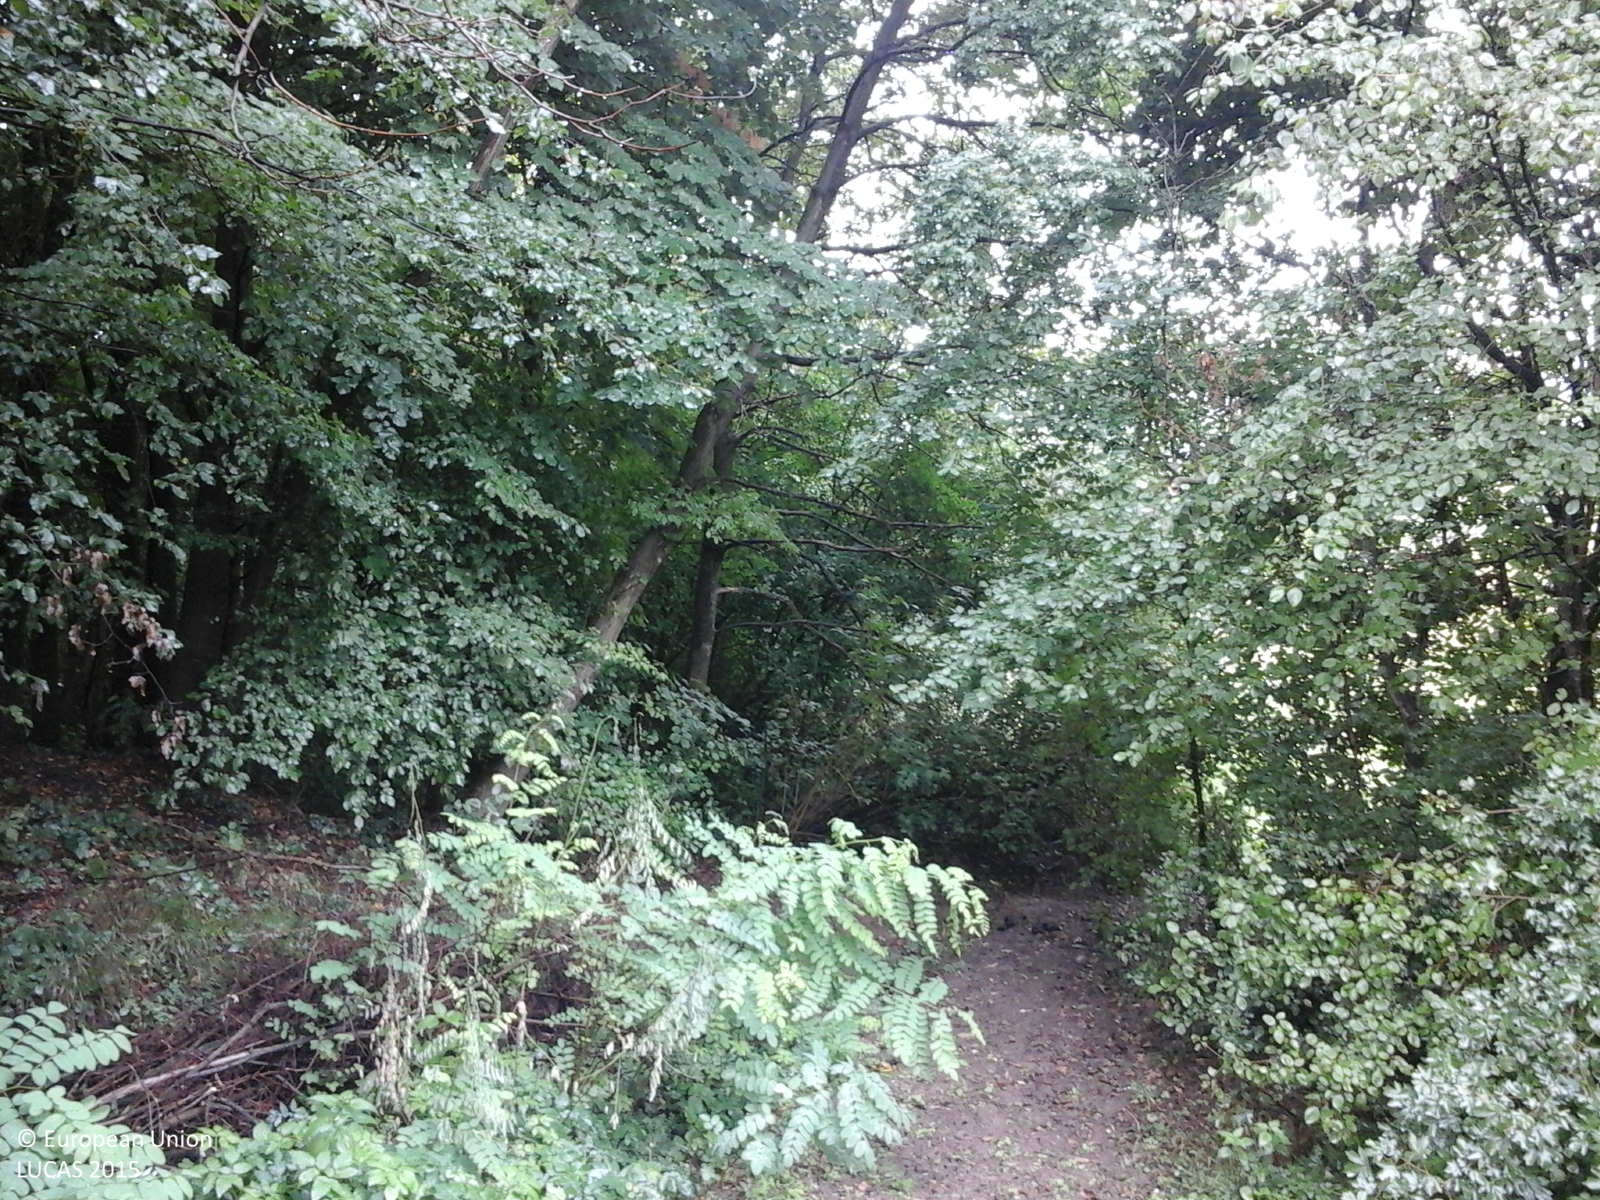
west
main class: Woodland
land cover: Broadleaved woodland
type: exotic forest
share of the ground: > 75 %
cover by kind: broadleaved forest trees 100 %
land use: Forestry
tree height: > 5 m
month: September
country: RO
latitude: 47.0304
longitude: 22.5426
